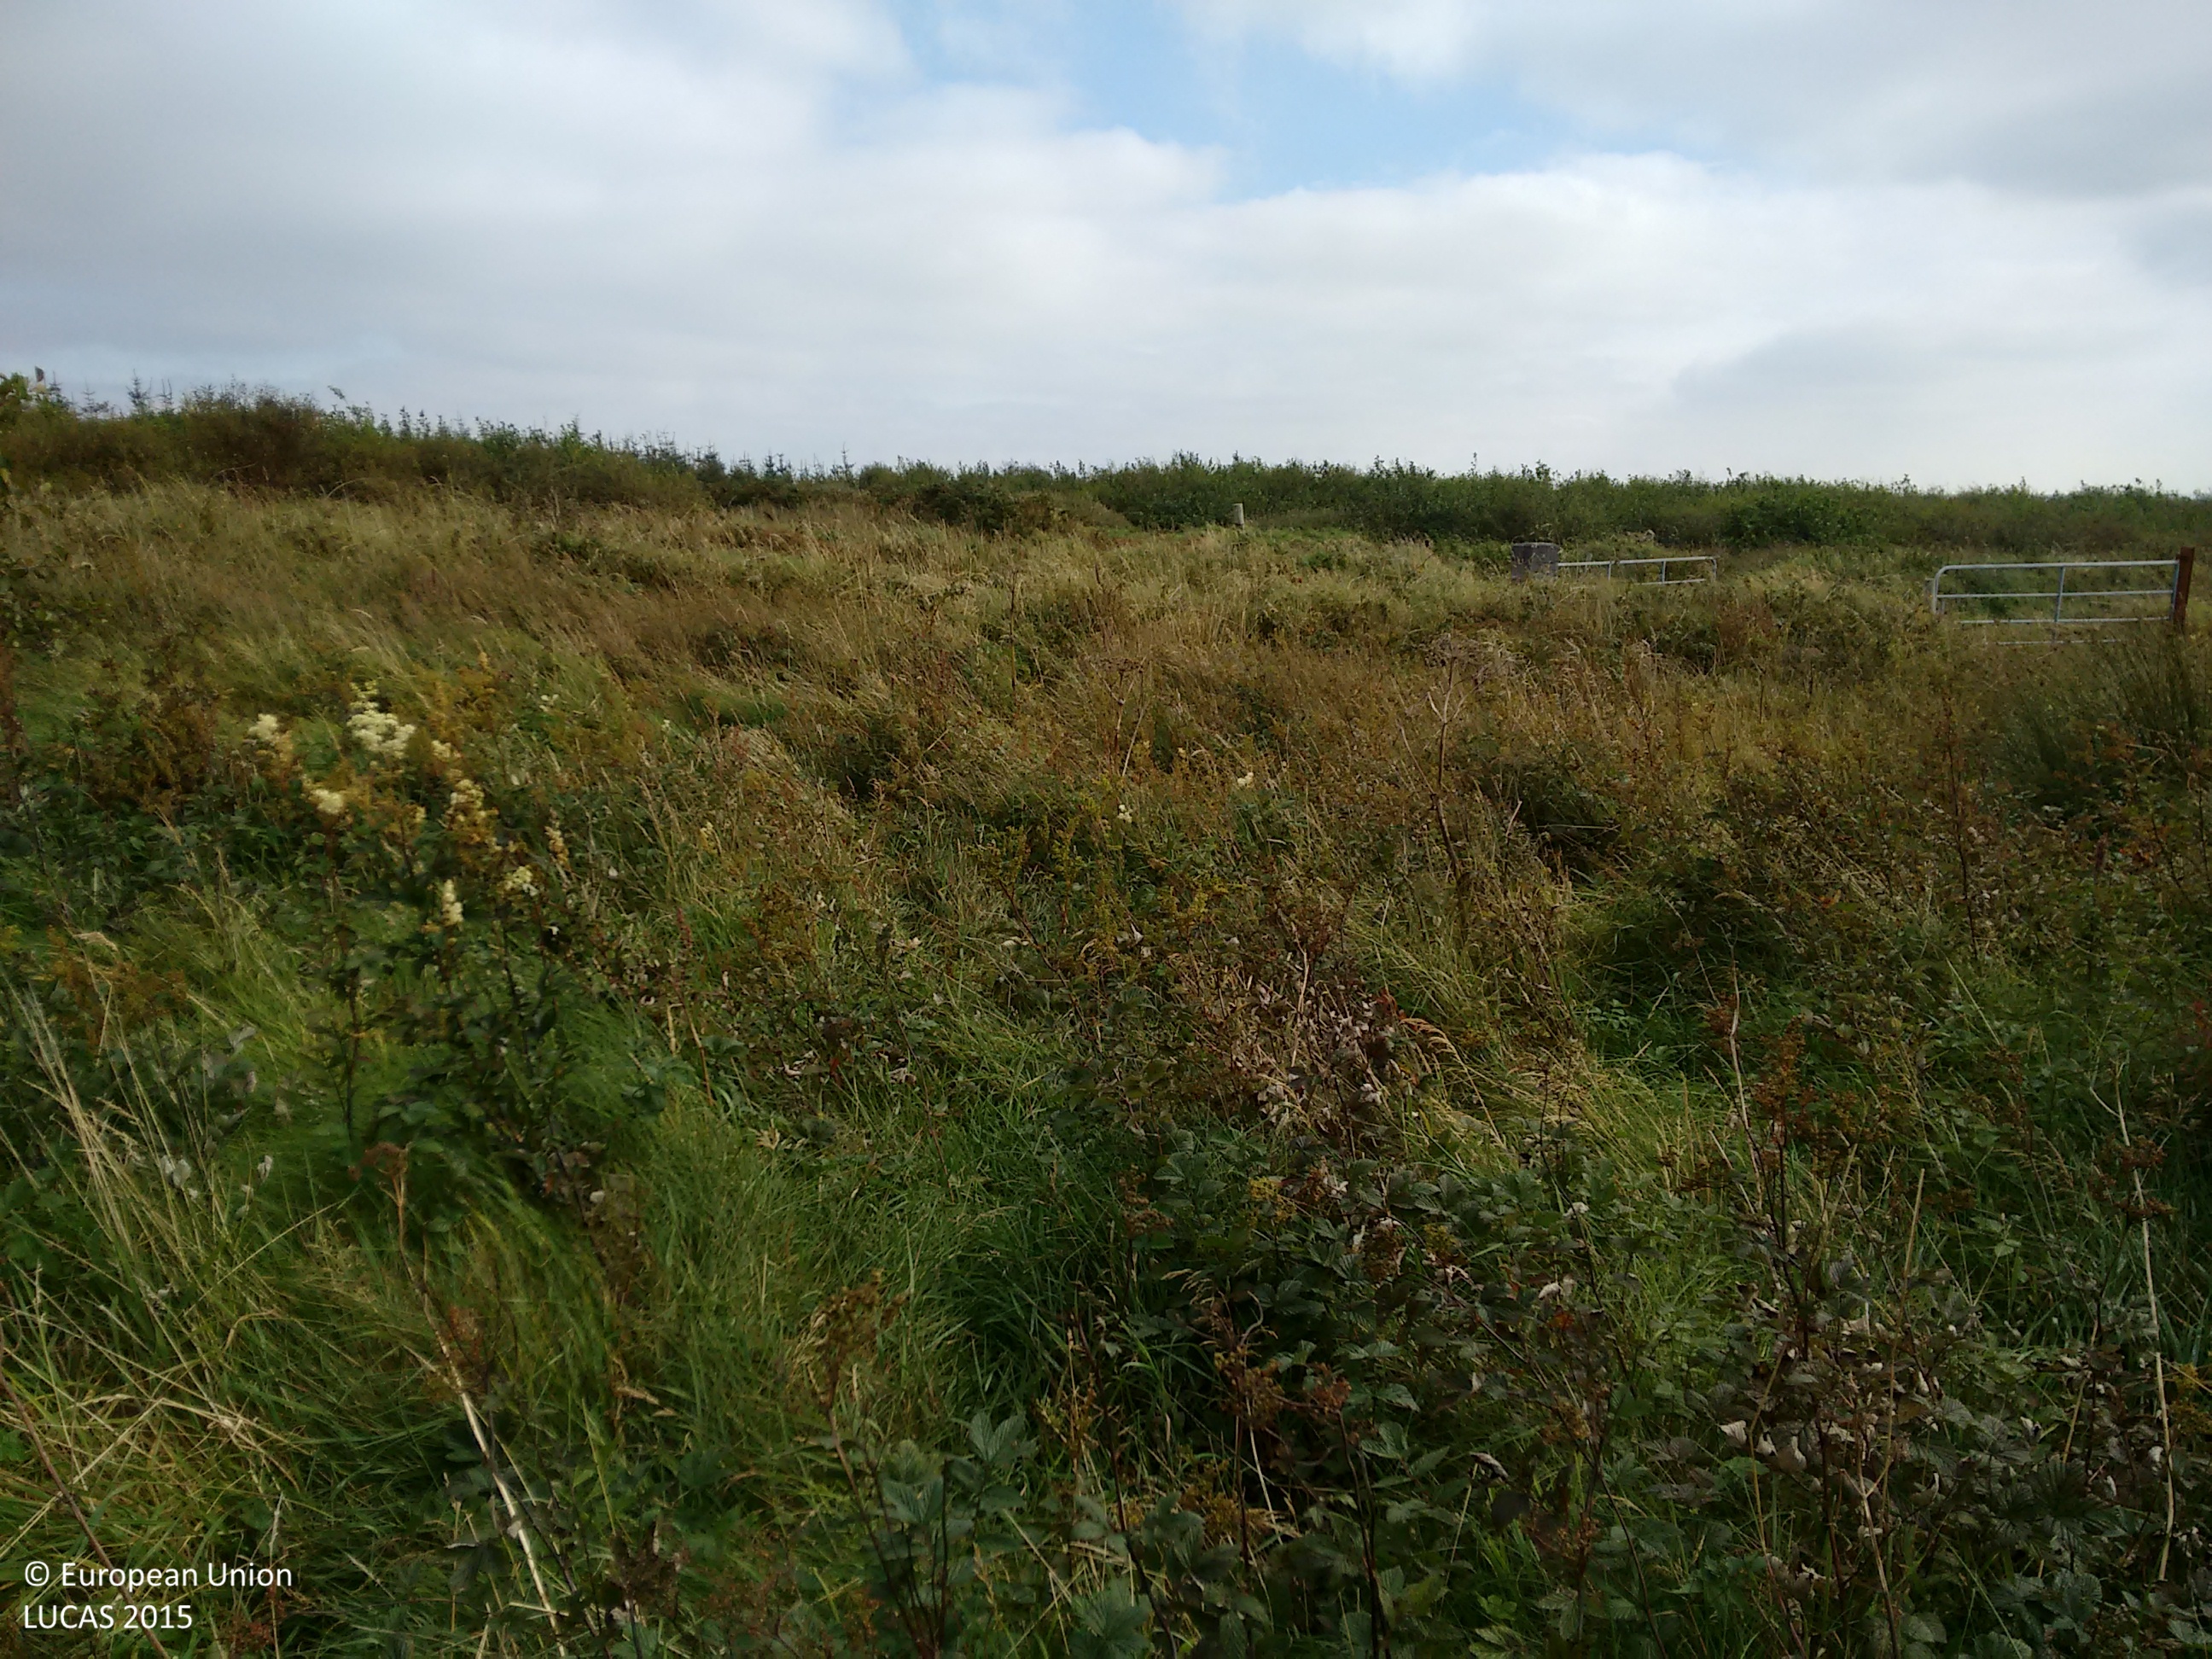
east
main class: Grassland
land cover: Grassland without tree/shrub cover
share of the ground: > 75 %
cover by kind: herbaceous plants 100 %
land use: Agriculture (excluding fallow land and kitchen gardens)
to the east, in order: Grassland without tree/shrub cover; Abandoned hedges; Rivers and streams; Abandoned hedges; Fences; Spontaneously vegetated surfaces; Paved roads, cycling and walking lanes; Spontaneously vegetated surfaces; Ditches and canals; Fences; Abandoned hedges; Grassland without tree/shrub cover; Shruby margins; Spontaneously vegetated surfaces; Broadleaved woodland; Spruce dominated coniferous woodland
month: September
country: IE
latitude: 52.9779
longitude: -9.3960
